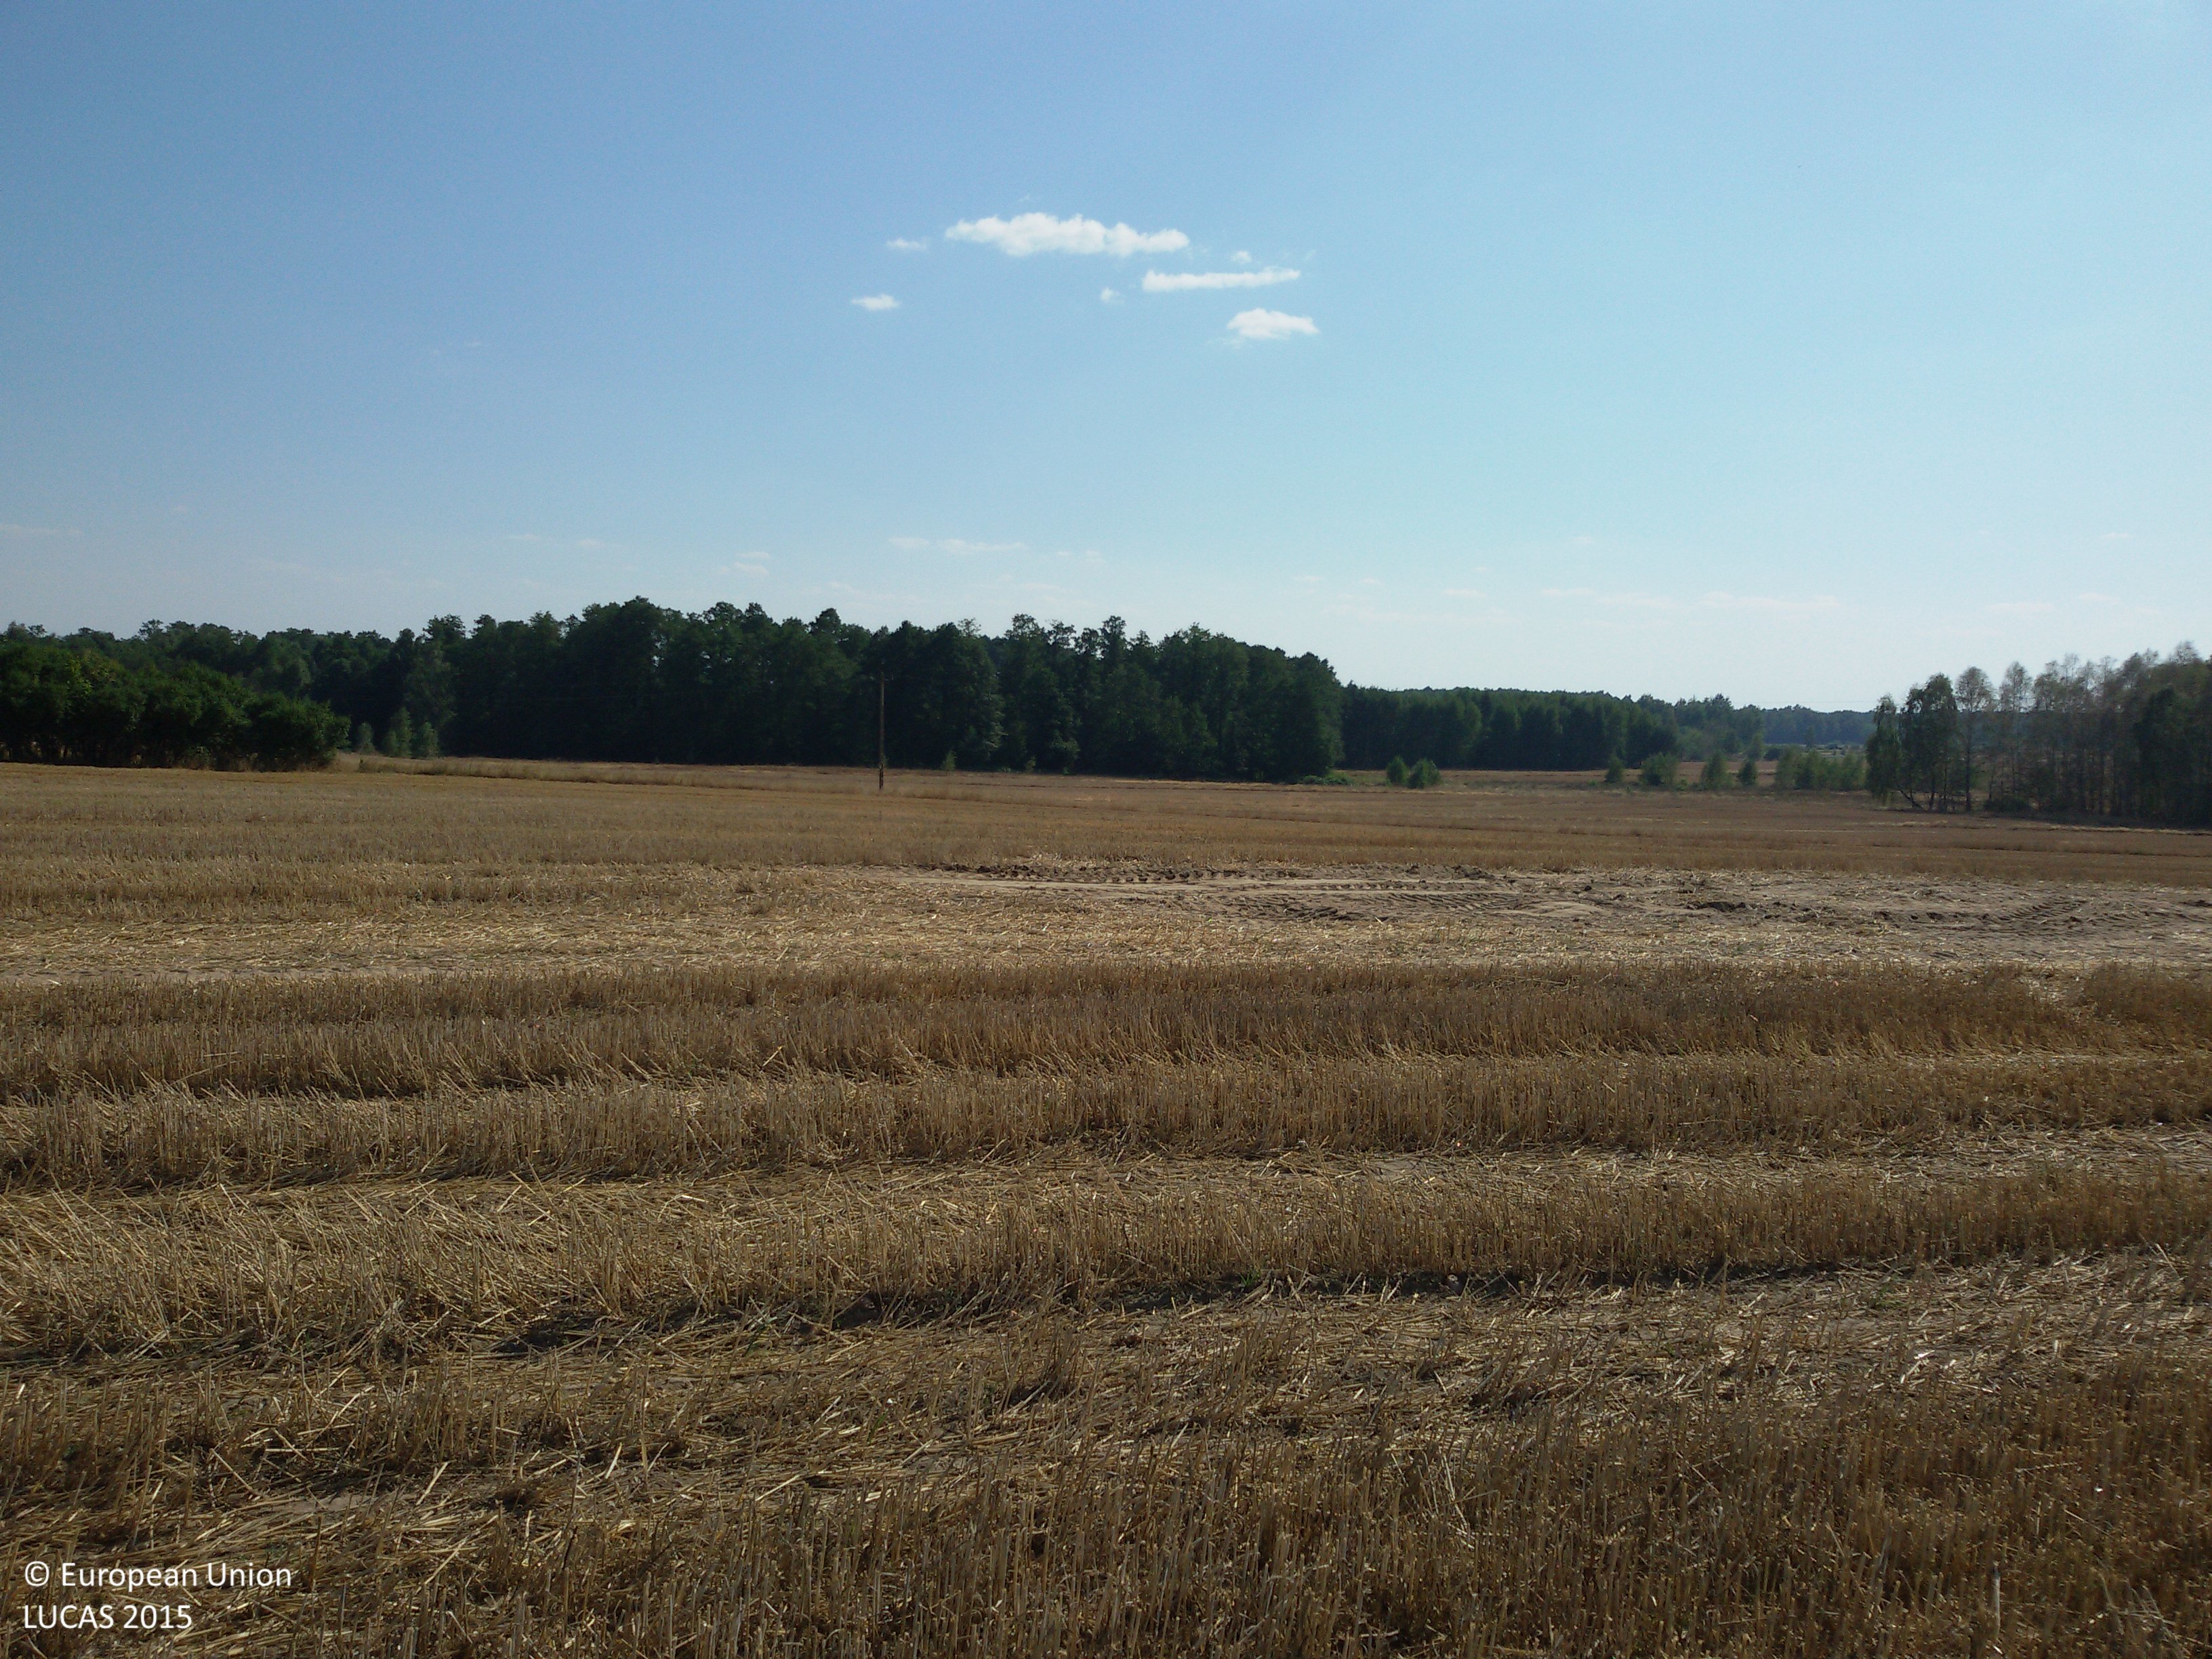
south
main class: Cropland
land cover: Rye
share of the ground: 50 - 75 %
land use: Agriculture (excluding fallow land and kitchen gardens)
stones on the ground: < 10 %
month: August
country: PL
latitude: 51.3167
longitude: 23.4411
